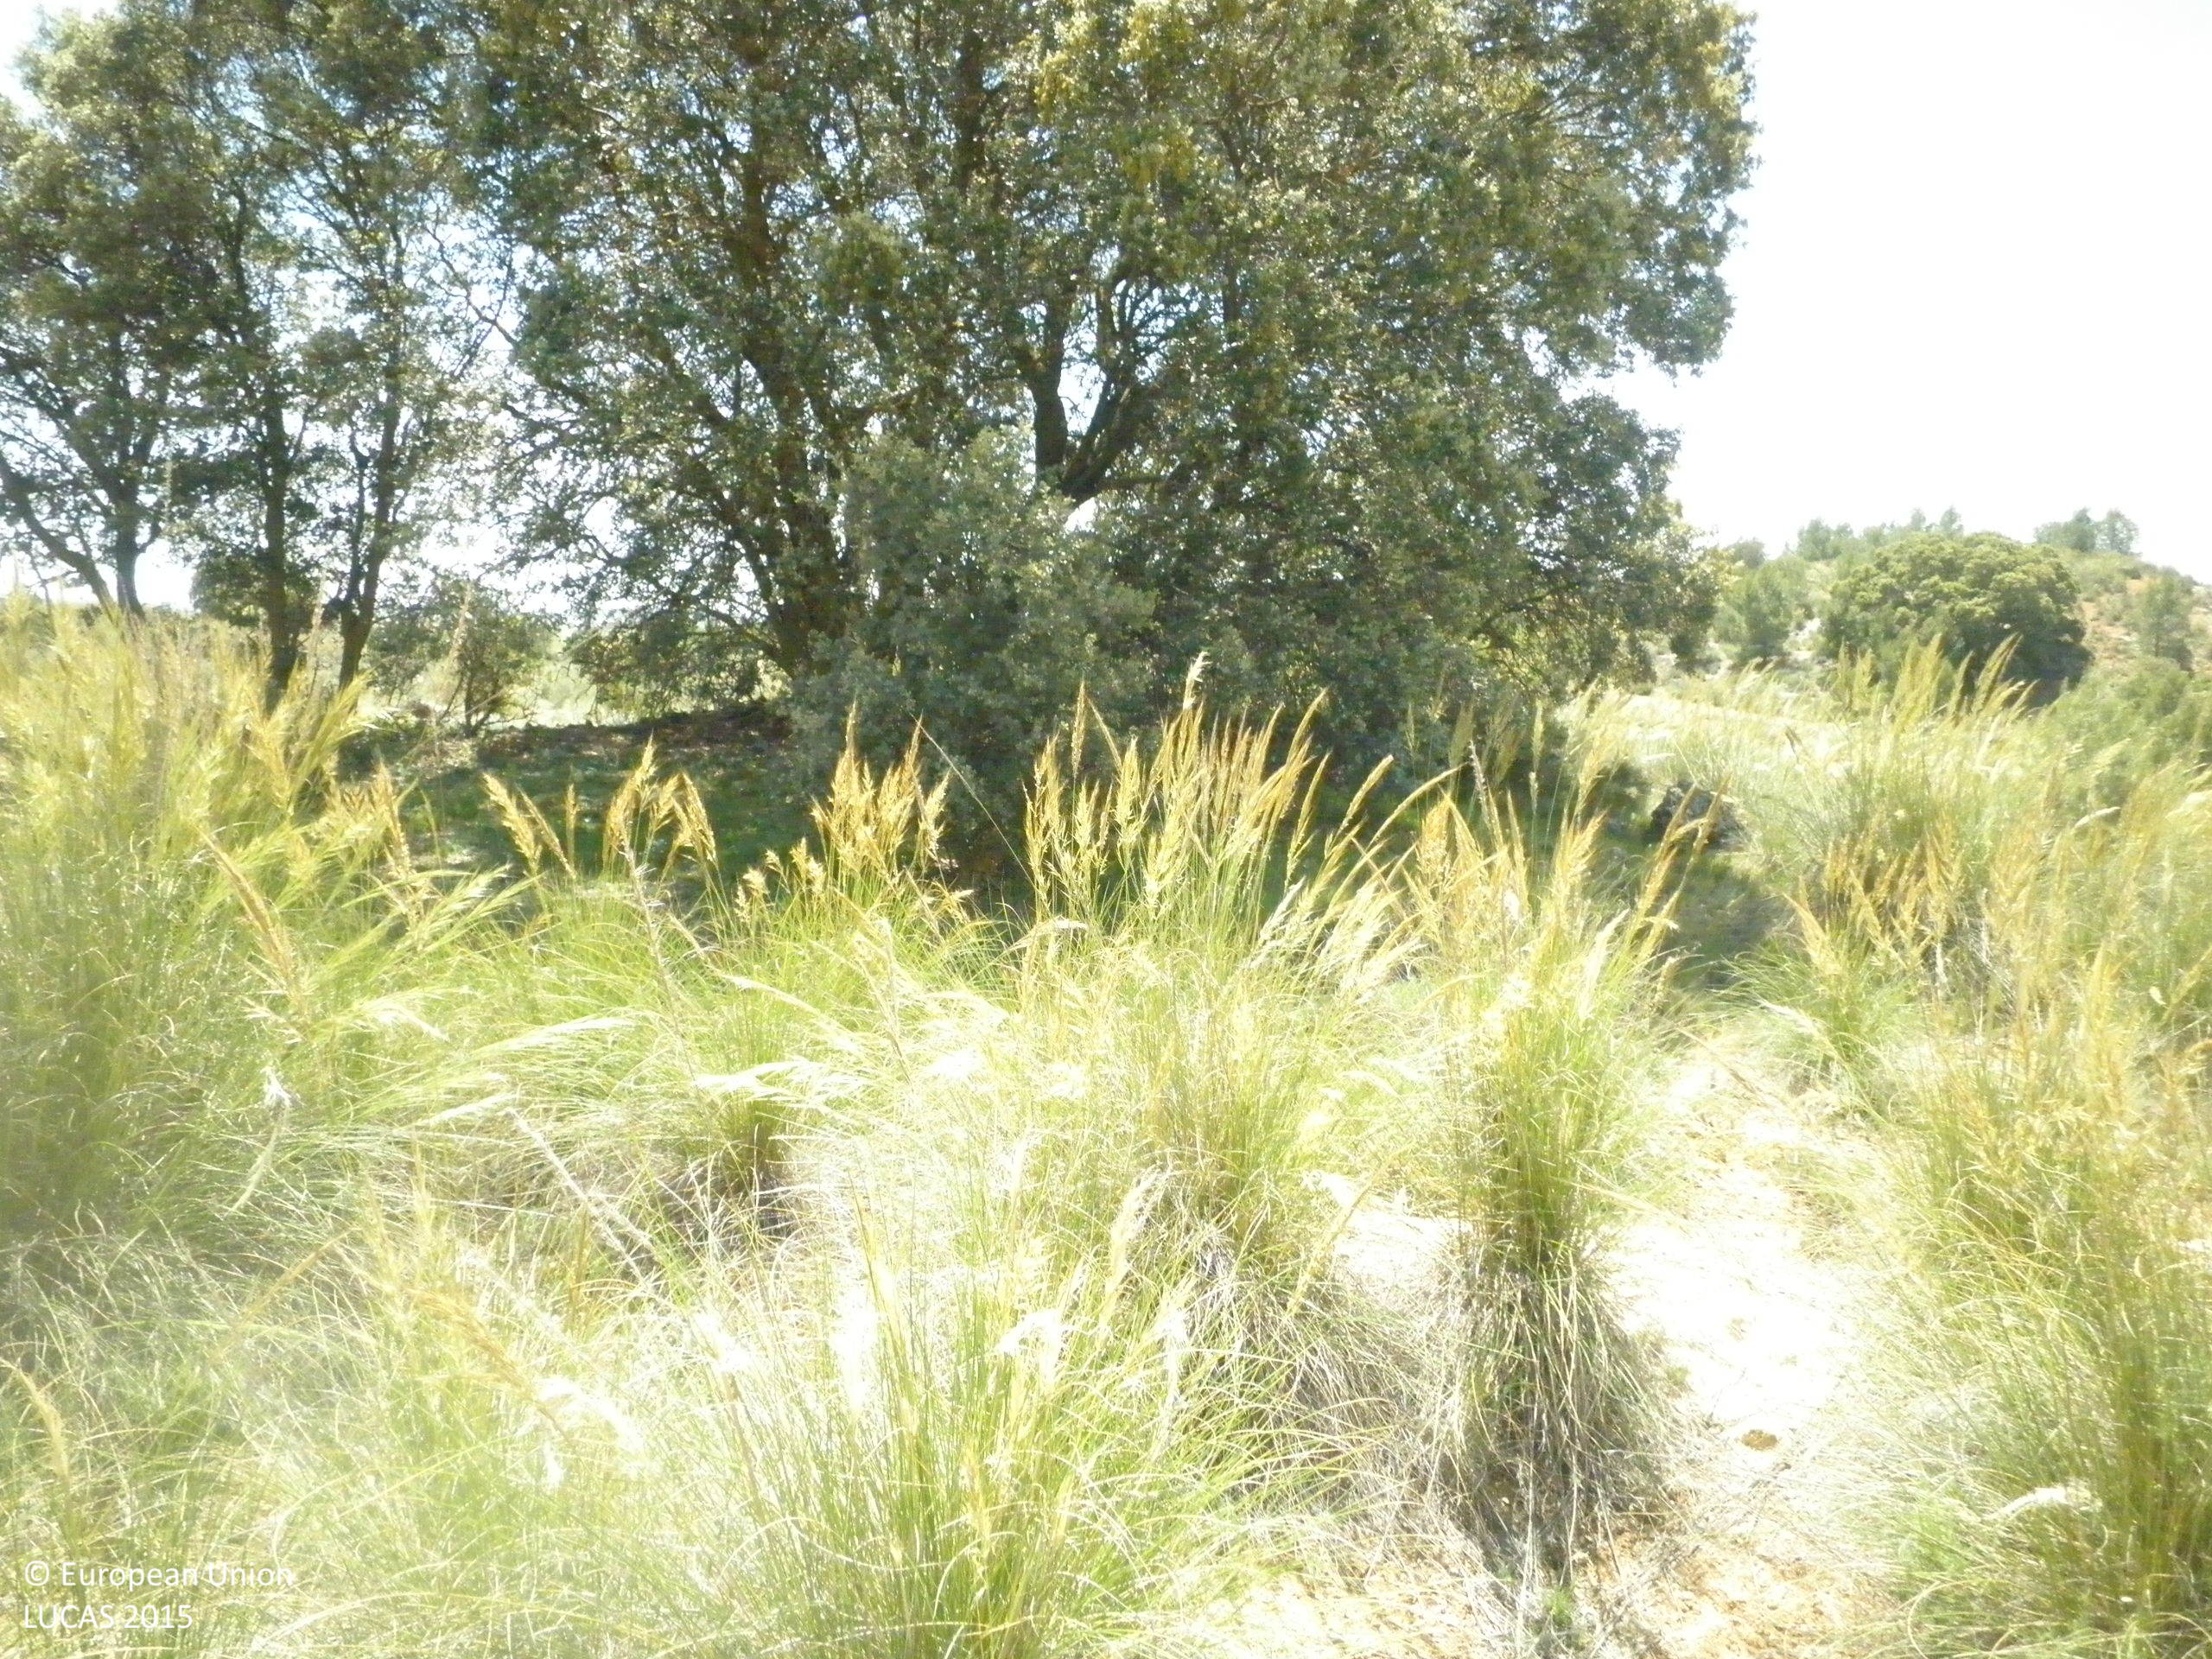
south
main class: Woodland
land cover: Broadleaved woodland
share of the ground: 10 - 25 %
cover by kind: unconsolidated bare surface 45 %, herbaceous plants 25 %, broadleaved forest trees 20 %, shrubs 10 %
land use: Semi-natural and natural areas not in use
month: May
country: ES
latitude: 39.6329
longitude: -2.7510
